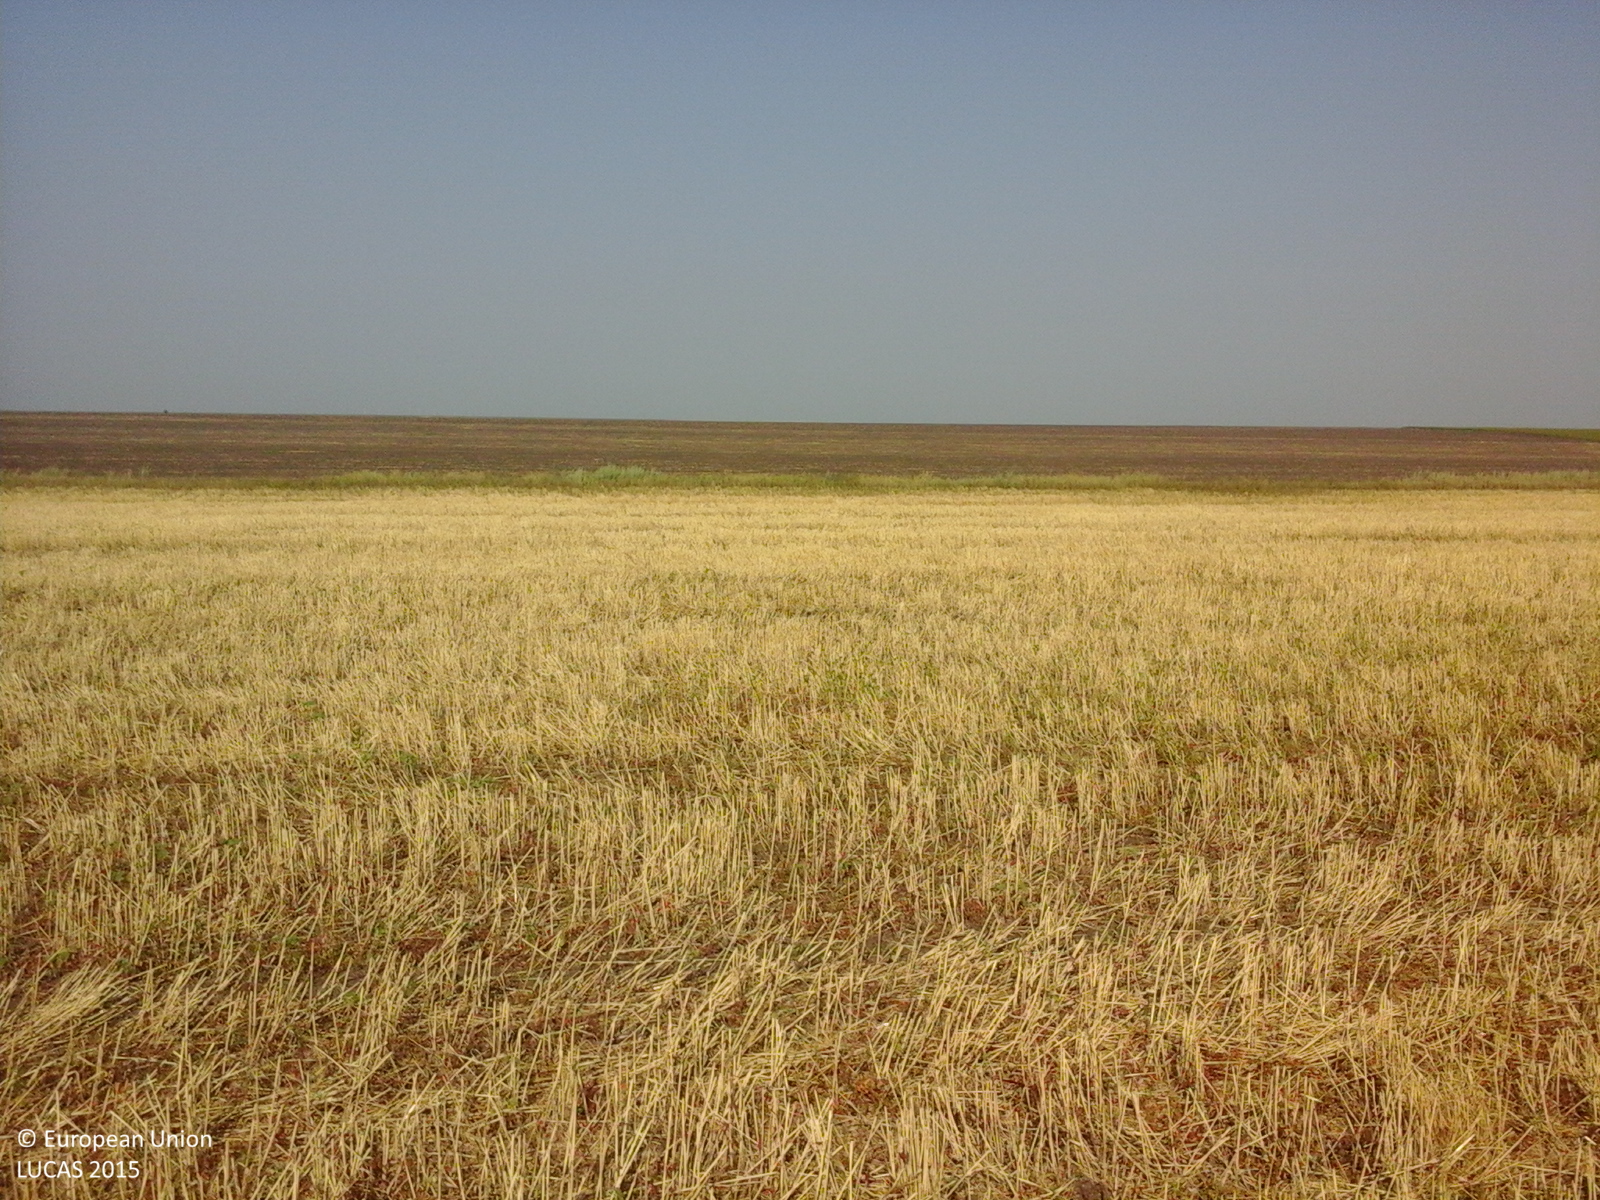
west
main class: Cropland
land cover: Common wheat
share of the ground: > 75 %
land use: Agriculture (excluding fallow land and kitchen gardens)
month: July
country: RO
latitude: 45.6653
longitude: 27.9457
